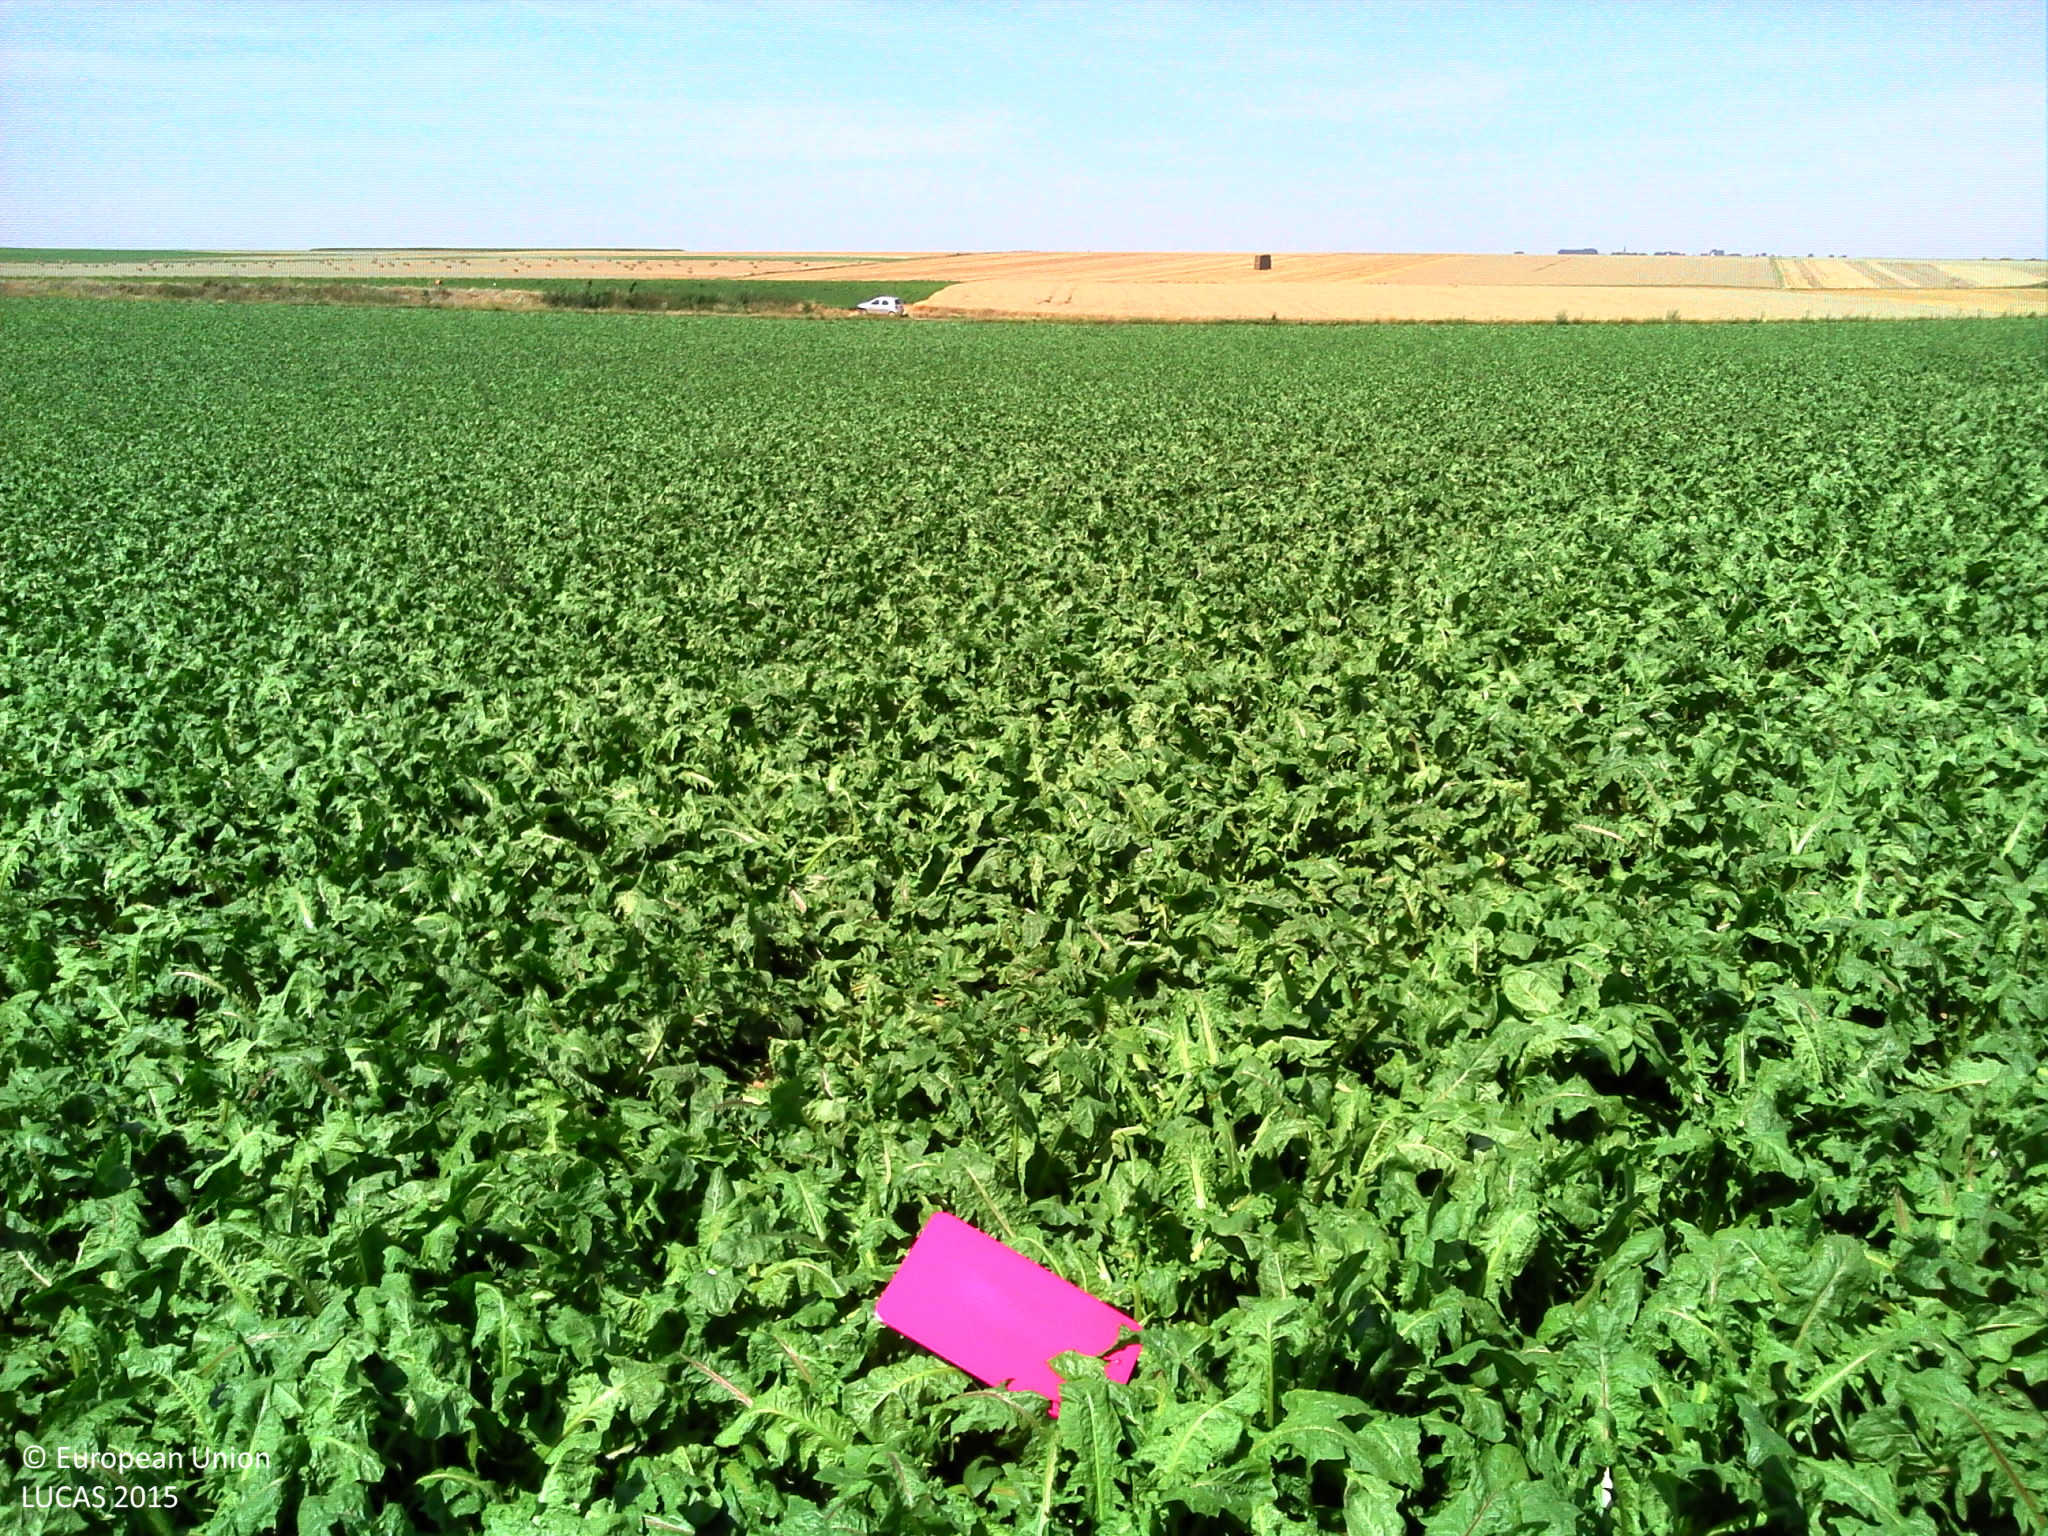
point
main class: Cropland
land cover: Other root crops
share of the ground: > 75 %
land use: Agriculture (excluding fallow land and kitchen gardens)
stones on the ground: < 10 %
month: August
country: FR
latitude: 50.2333
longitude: 3.1917
